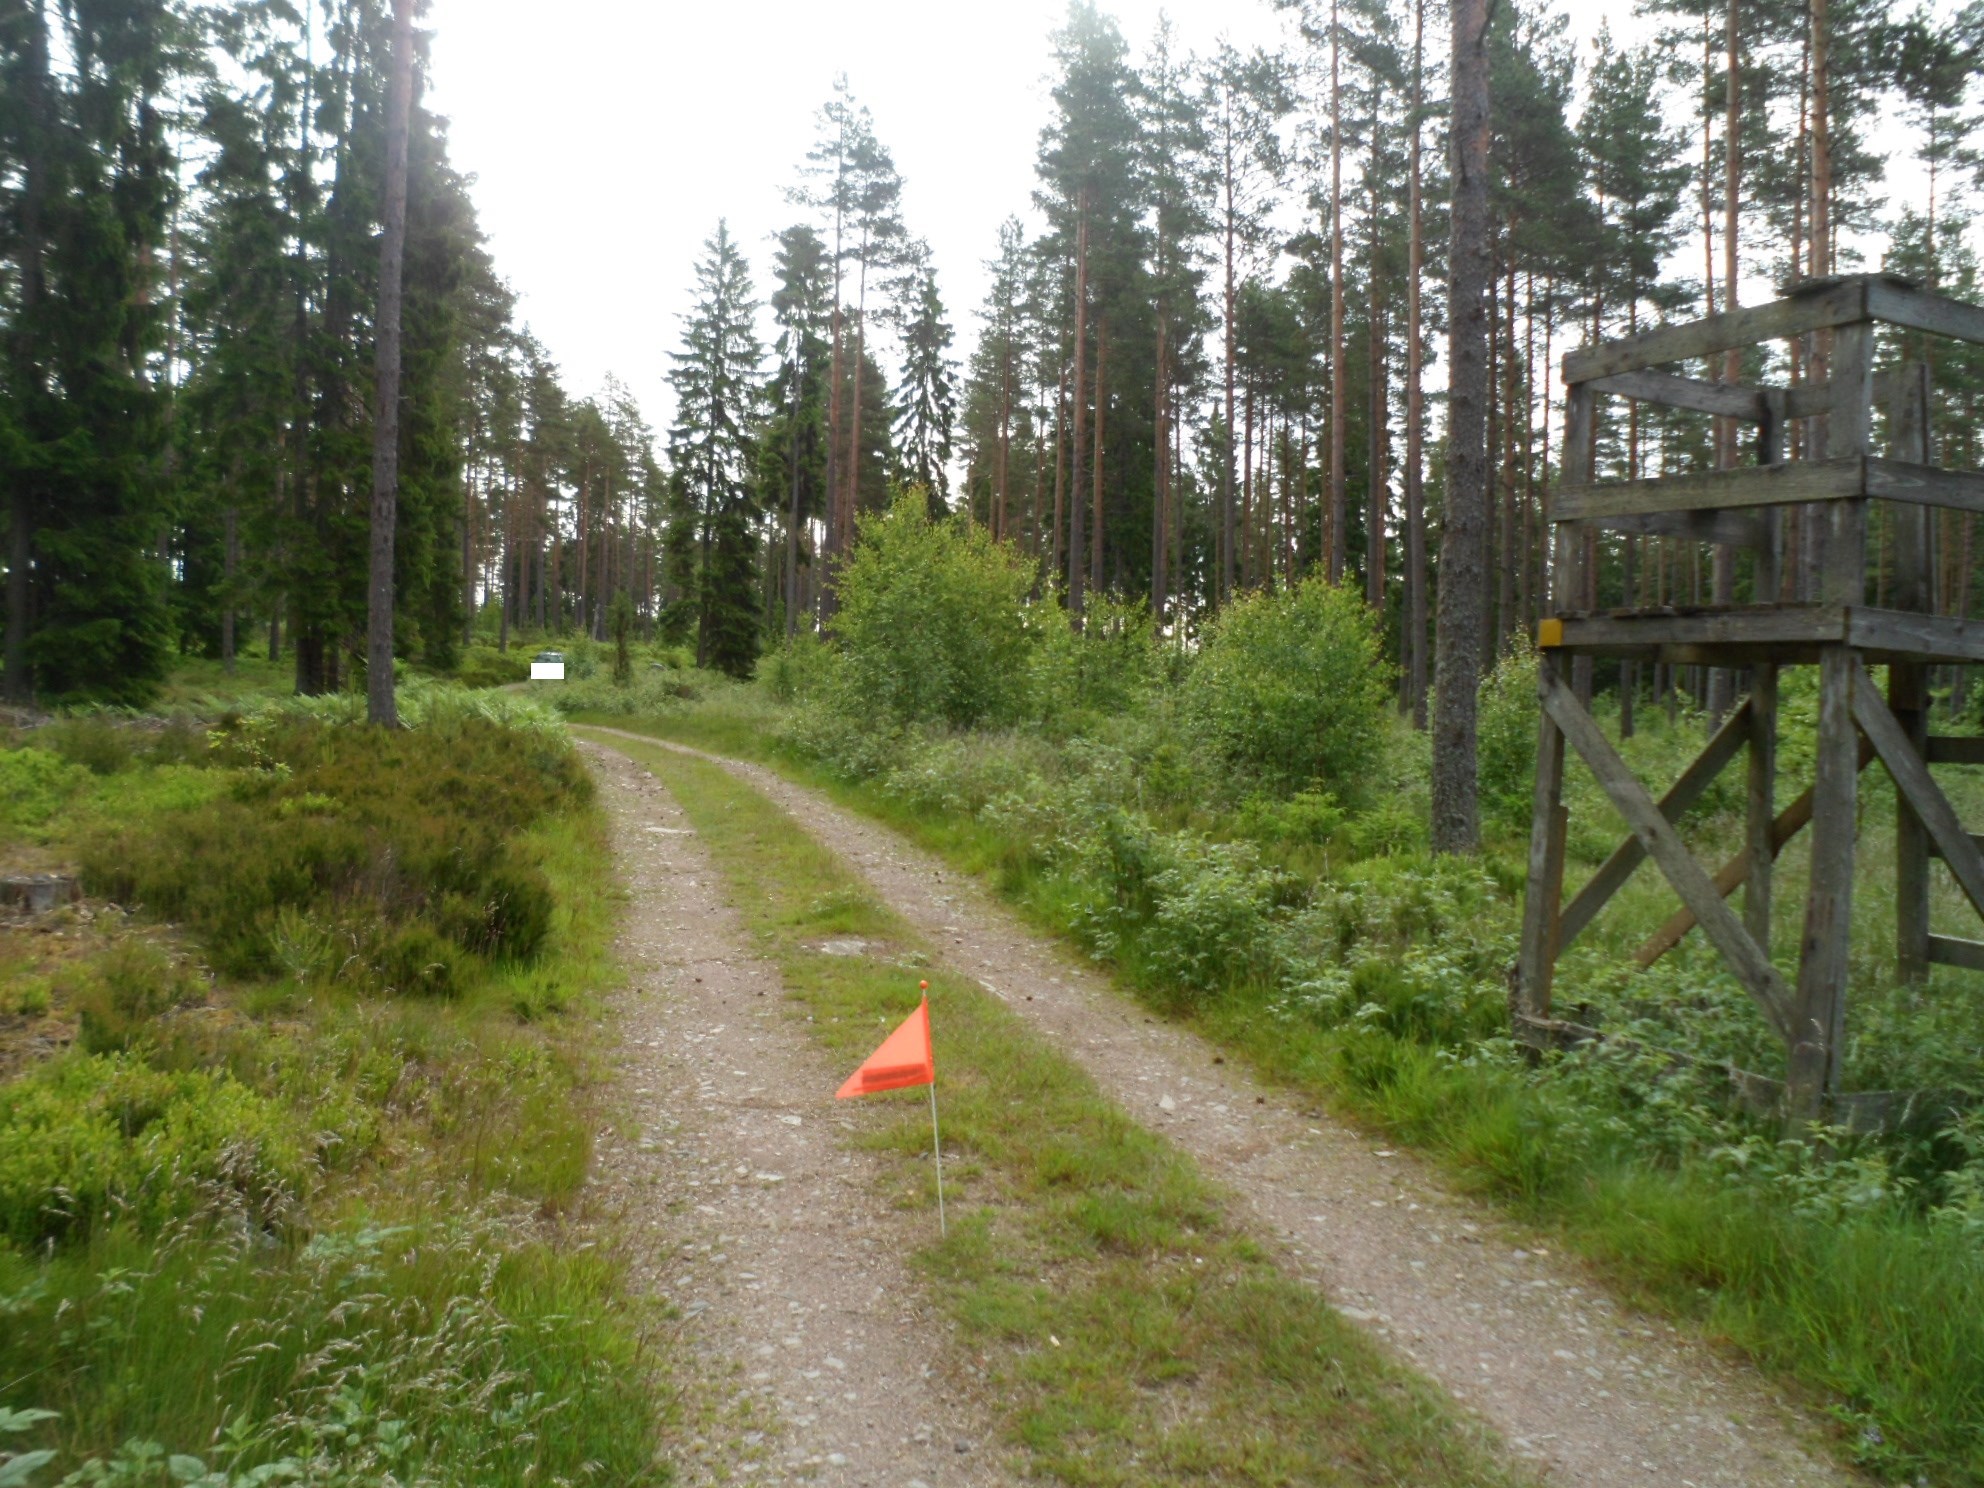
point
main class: Woodland
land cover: Pine dominated coniferous woodland
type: boreal forest
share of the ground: 25 - 50 %
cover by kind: coniferous forest trees 50 %, shrubs 35 %, herbaceous plants 10 %, lichens and mosses 5 %
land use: Forestry
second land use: Amenities, museums, leisure
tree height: > 5 m
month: June
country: SE
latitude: 56.9995
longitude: 15.2490
